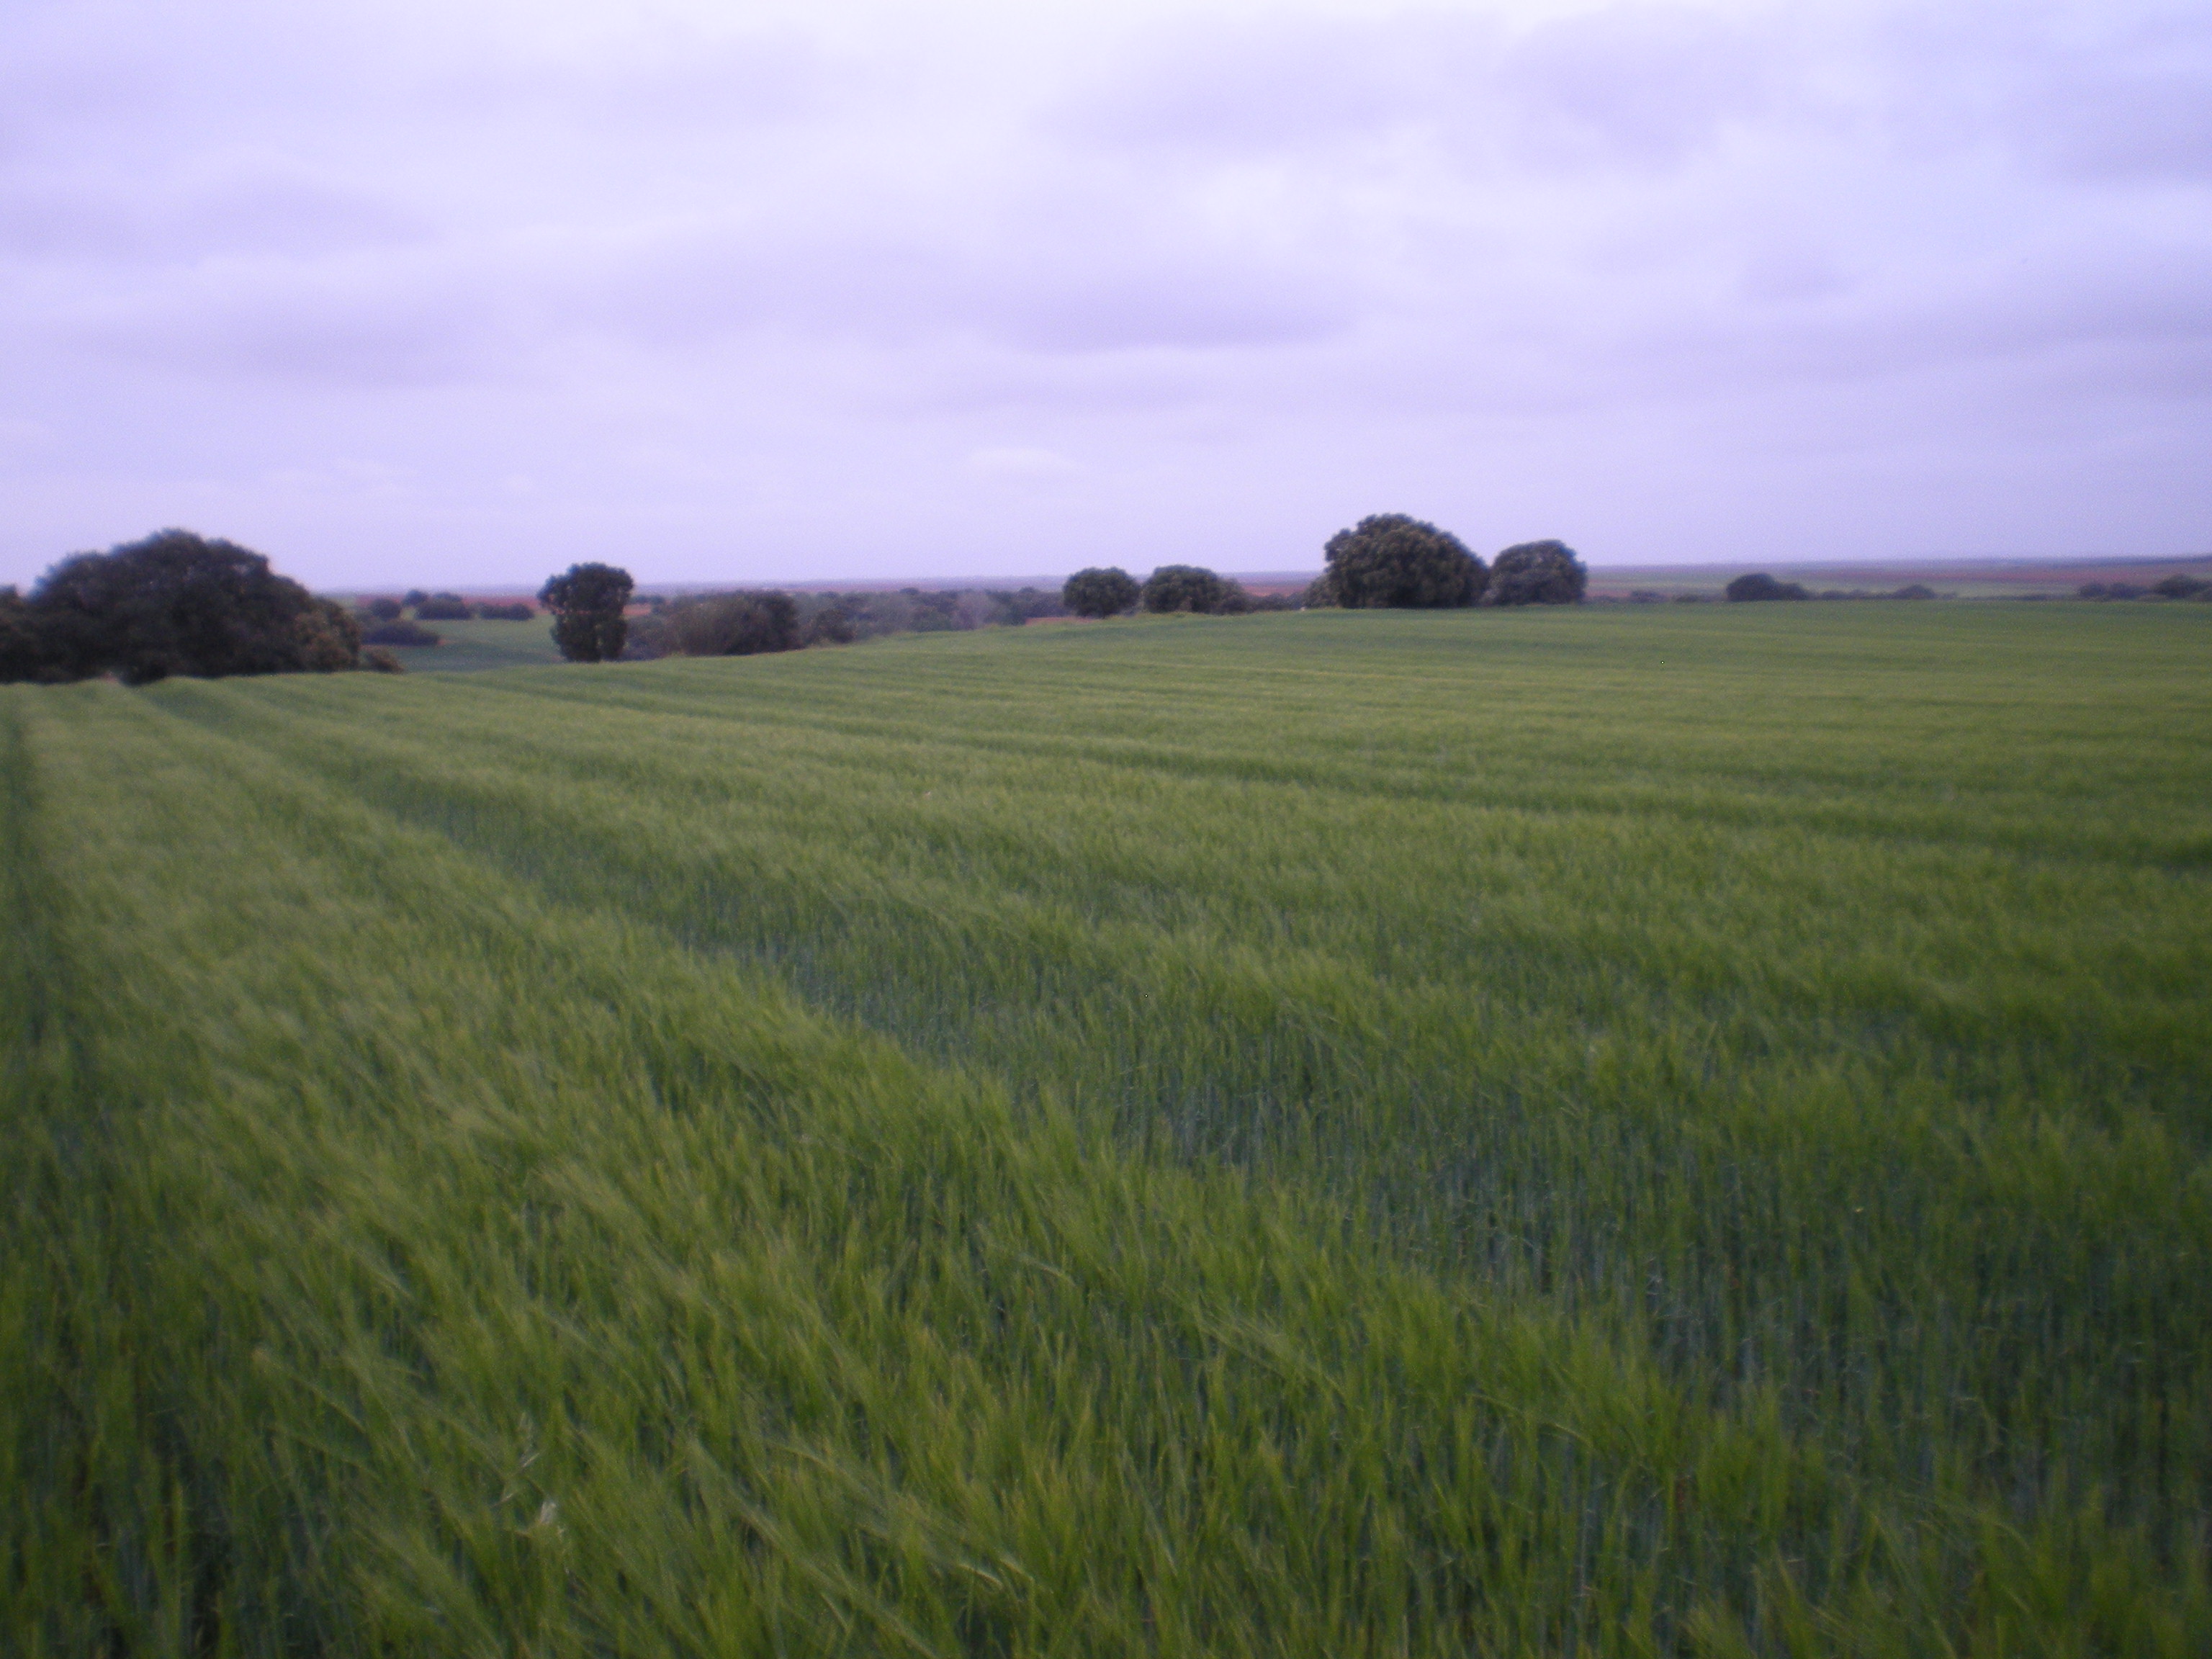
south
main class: Cropland
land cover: Barley
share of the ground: > 75 %
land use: Agriculture (excluding fallow land and kitchen gardens)
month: May
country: ES
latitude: 38.8585
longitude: -3.0655
